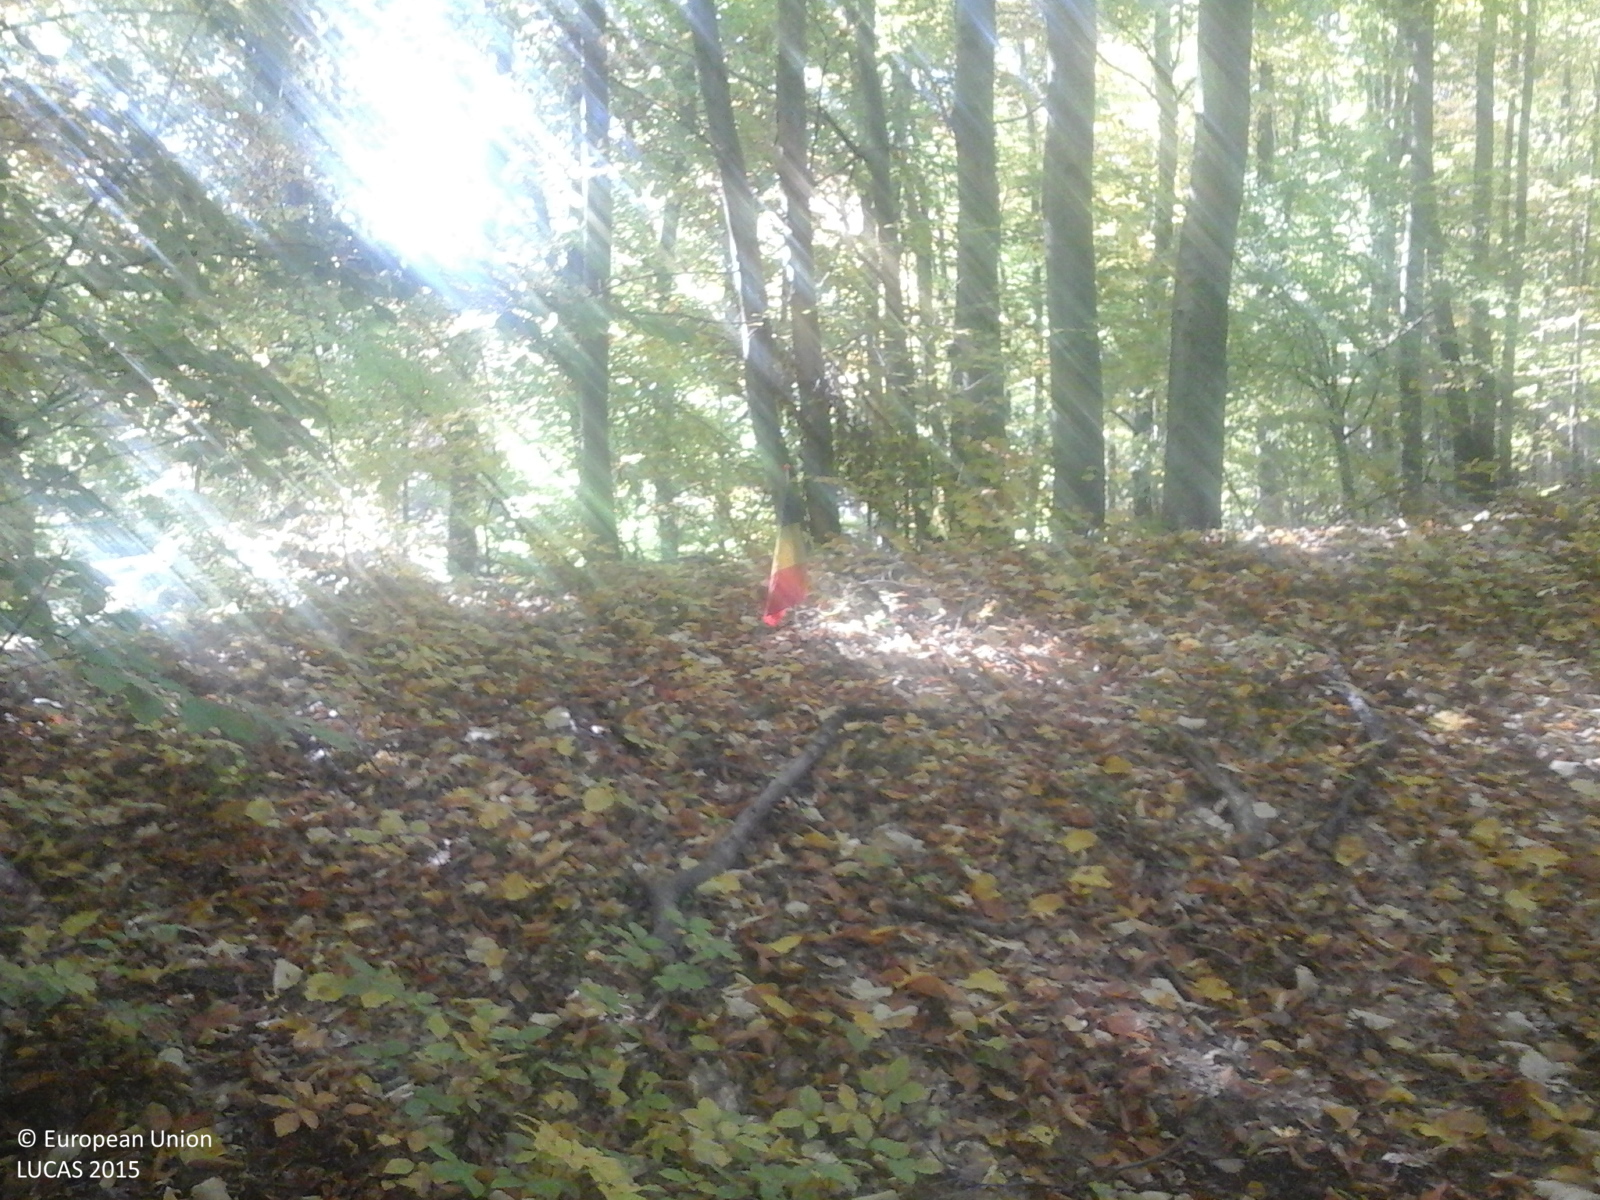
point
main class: Woodland
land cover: Broadleaved woodland
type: beech forest
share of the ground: > 75 %
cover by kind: broadleaved forest trees 100 %
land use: Forestry
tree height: > 5 m
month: October
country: RO
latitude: 45.2352
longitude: 26.5436
